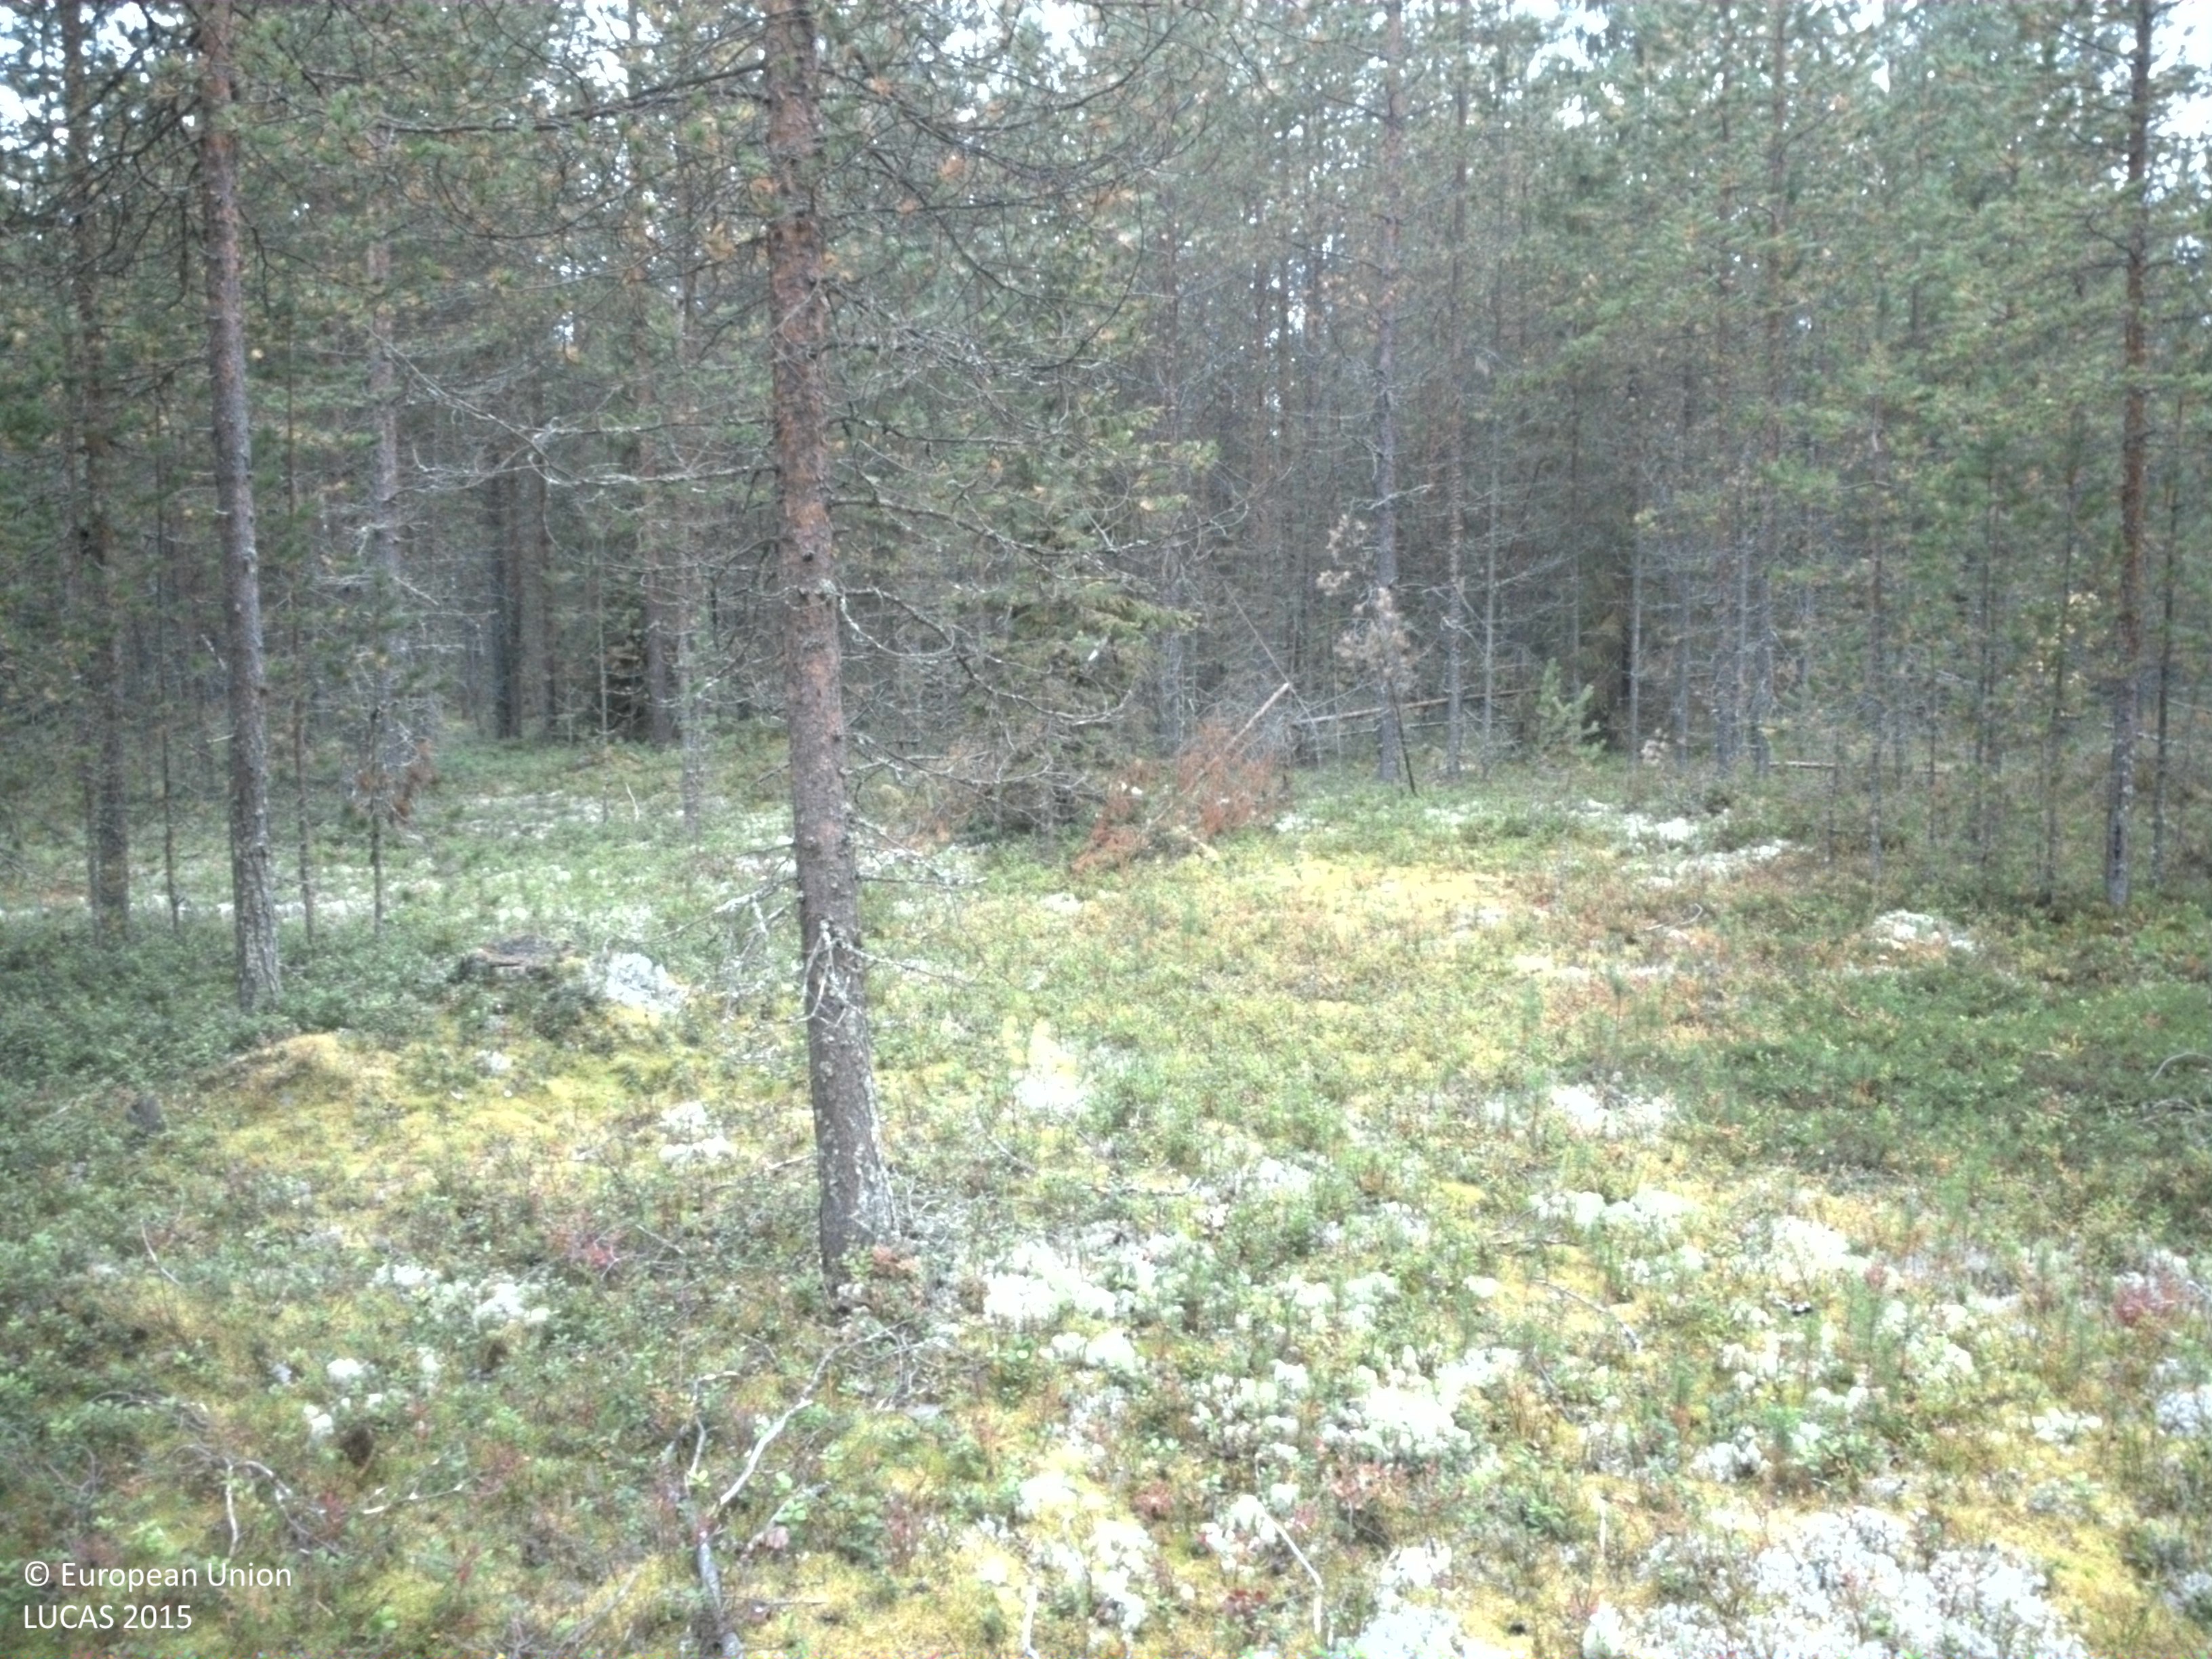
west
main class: Woodland
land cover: Pine dominated coniferous woodland
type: boreal forest
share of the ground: 25 - 50 %
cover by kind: shrubs 60 %, coniferous forest trees 30 %, lichens and mosses 10 %
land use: Forestry
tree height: > 5 m
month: September
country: SE
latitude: 65.5683
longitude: 22.0477
